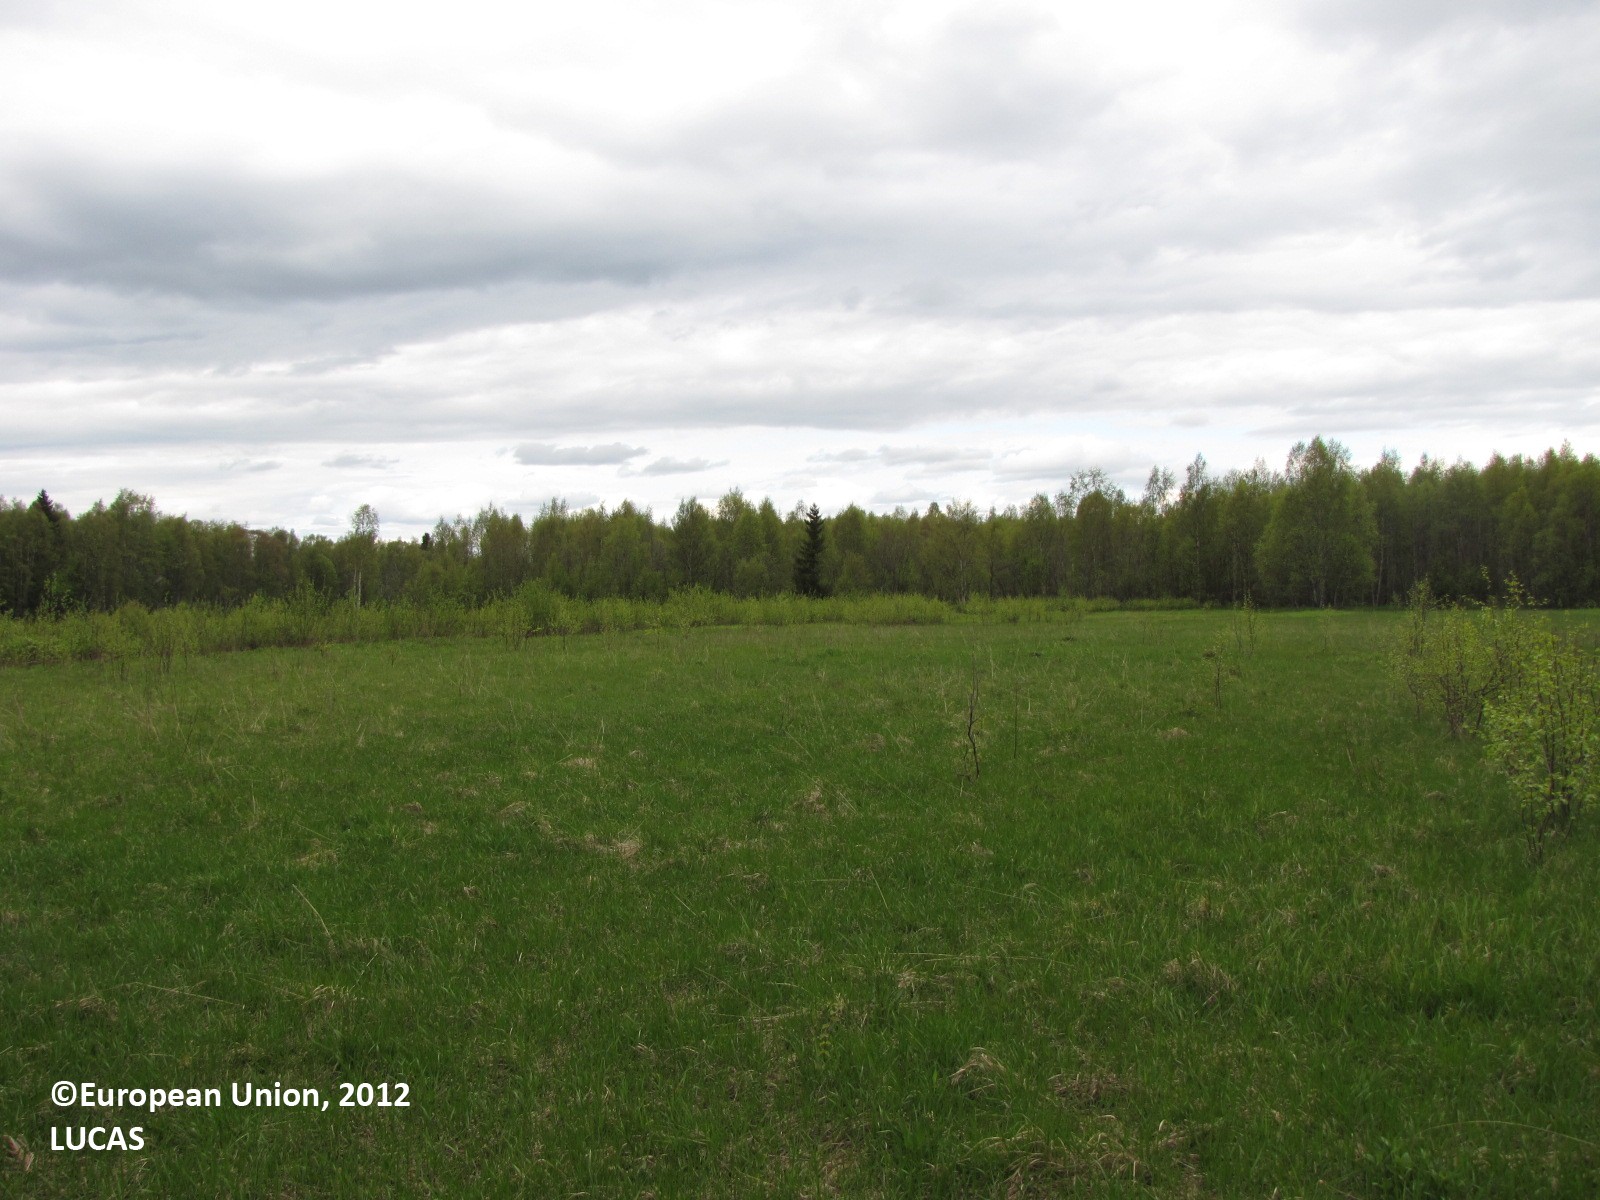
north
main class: Grassland
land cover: Grassland with sparse tree/shrub cover
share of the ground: > 75 %
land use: Agriculture (excluding fallow land and kitchen gardens)
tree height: < 5 m
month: June
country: FI
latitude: 65.7971
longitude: 24.4586
